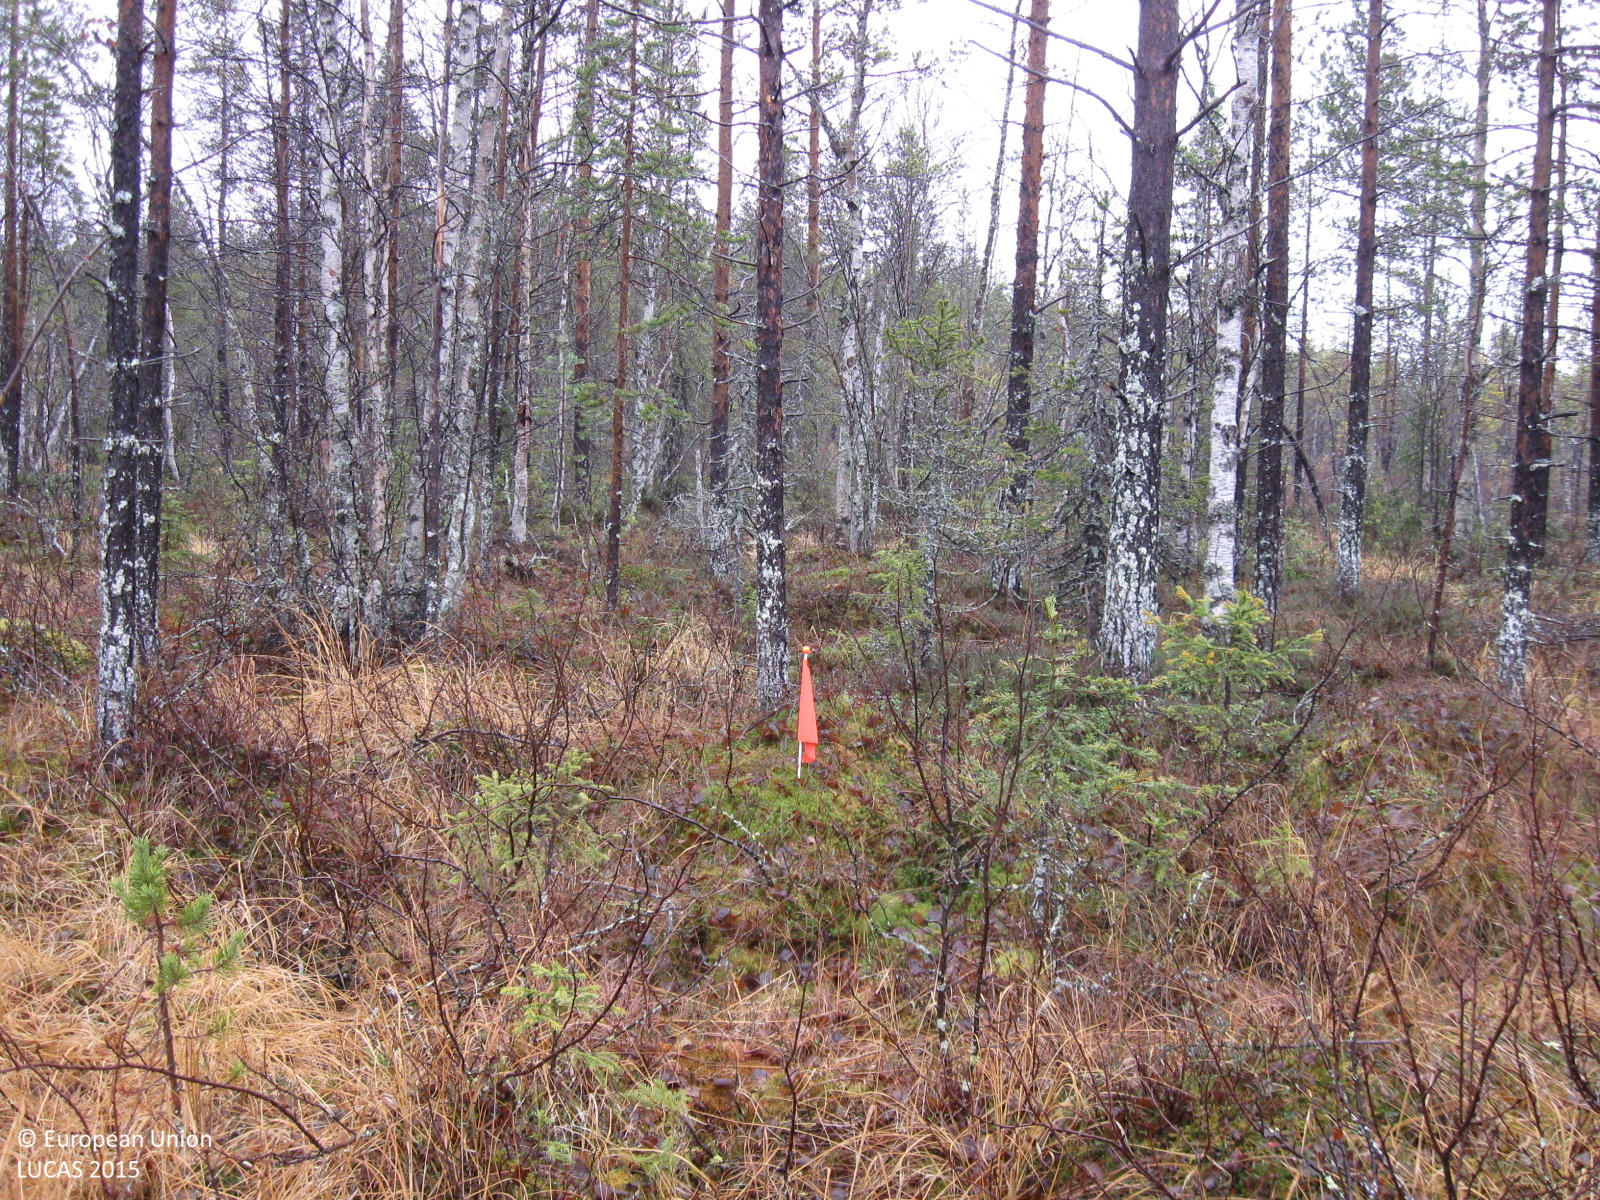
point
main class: Woodland
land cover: Pine dominated mixed woodland
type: mire and swamp forests
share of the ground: 50 - 75 %
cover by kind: coniferous forest trees 40 %, shrubs 25 %, broadleaved forest trees 20 %, herbaceous plants 10 %, lichens and mosses 5 %
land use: Forestry
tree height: > 5 m
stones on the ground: < 10 %
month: October
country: SE
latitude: 66.5738
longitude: 21.0258
